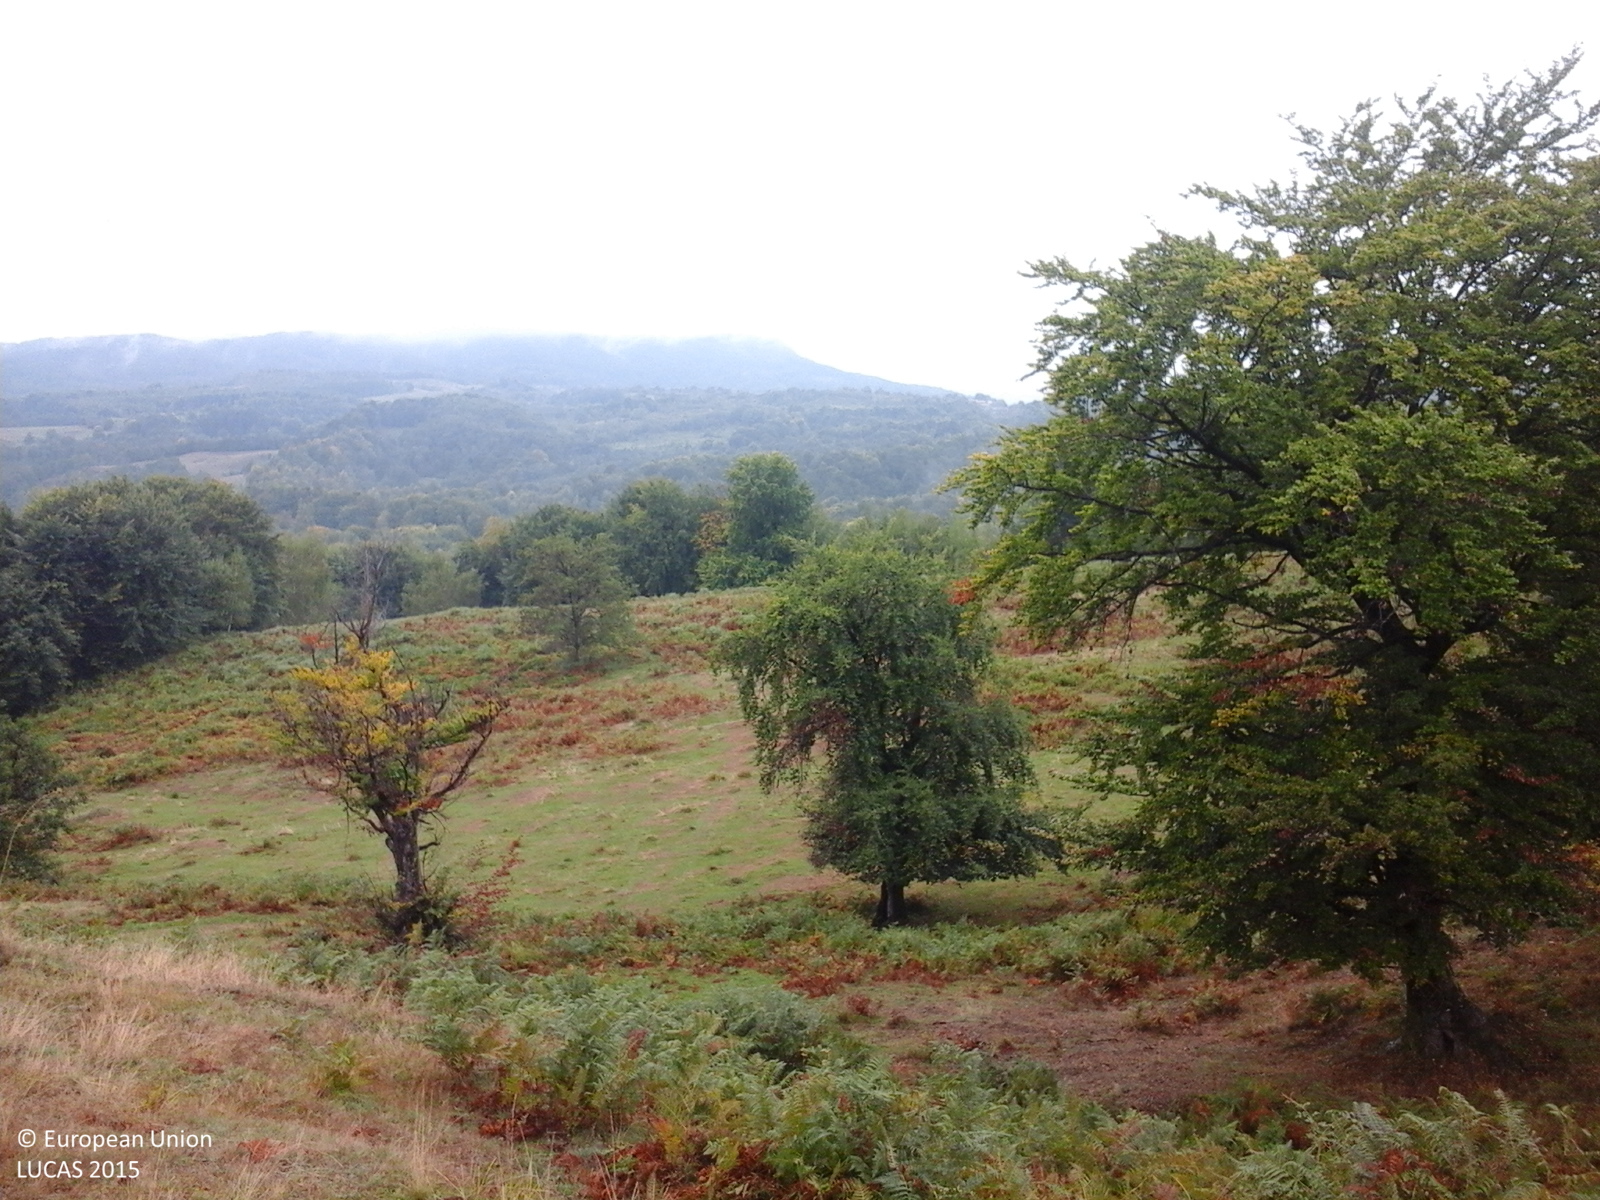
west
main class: Grassland
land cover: Grassland without tree/shrub cover
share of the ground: > 75 %
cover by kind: herbaceous plants 100 %
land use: Agriculture (excluding fallow land and kitchen gardens)
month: September
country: RO
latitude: 45.2452
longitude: 24.5125
